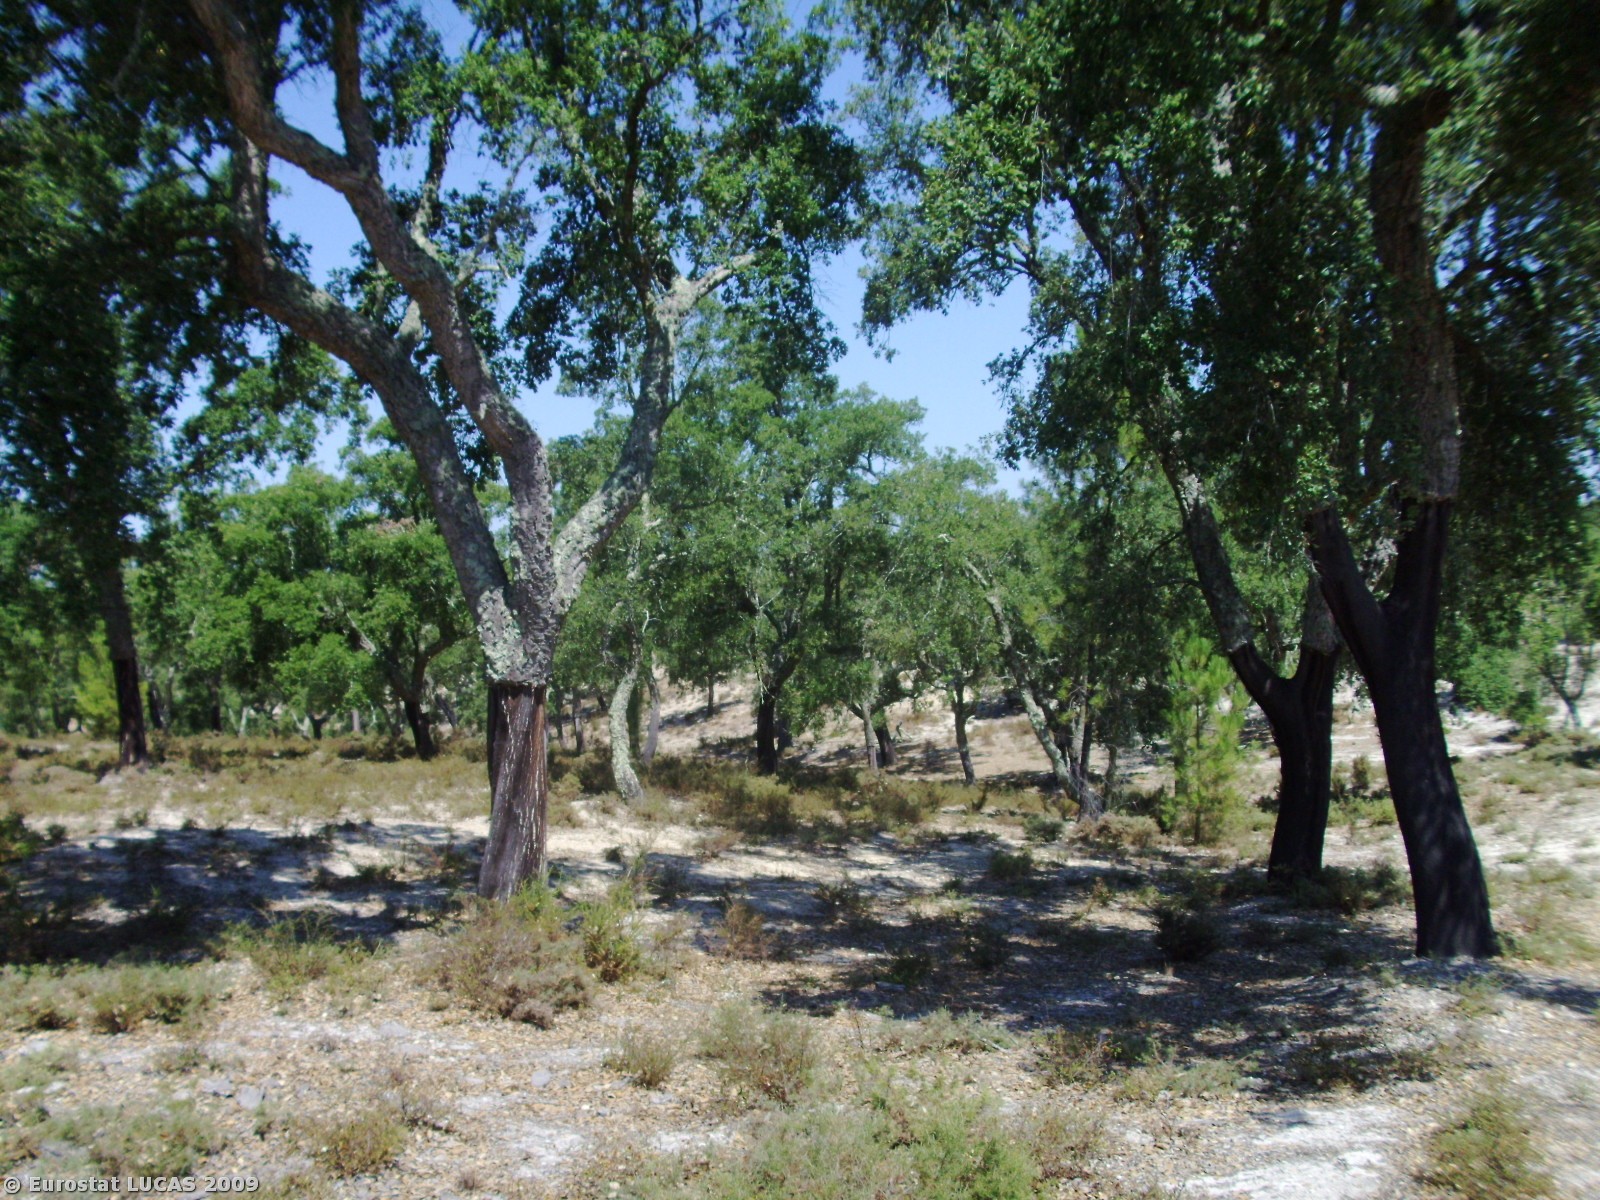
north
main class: Woodland
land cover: Broadleaved woodland
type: broadleaved evergreen forest
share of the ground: 25 - 50 %
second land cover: Bare land
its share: 25 - 50 %
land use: Forestry
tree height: > 5 m
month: August
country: PT
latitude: 39.2563
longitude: -8.0770
